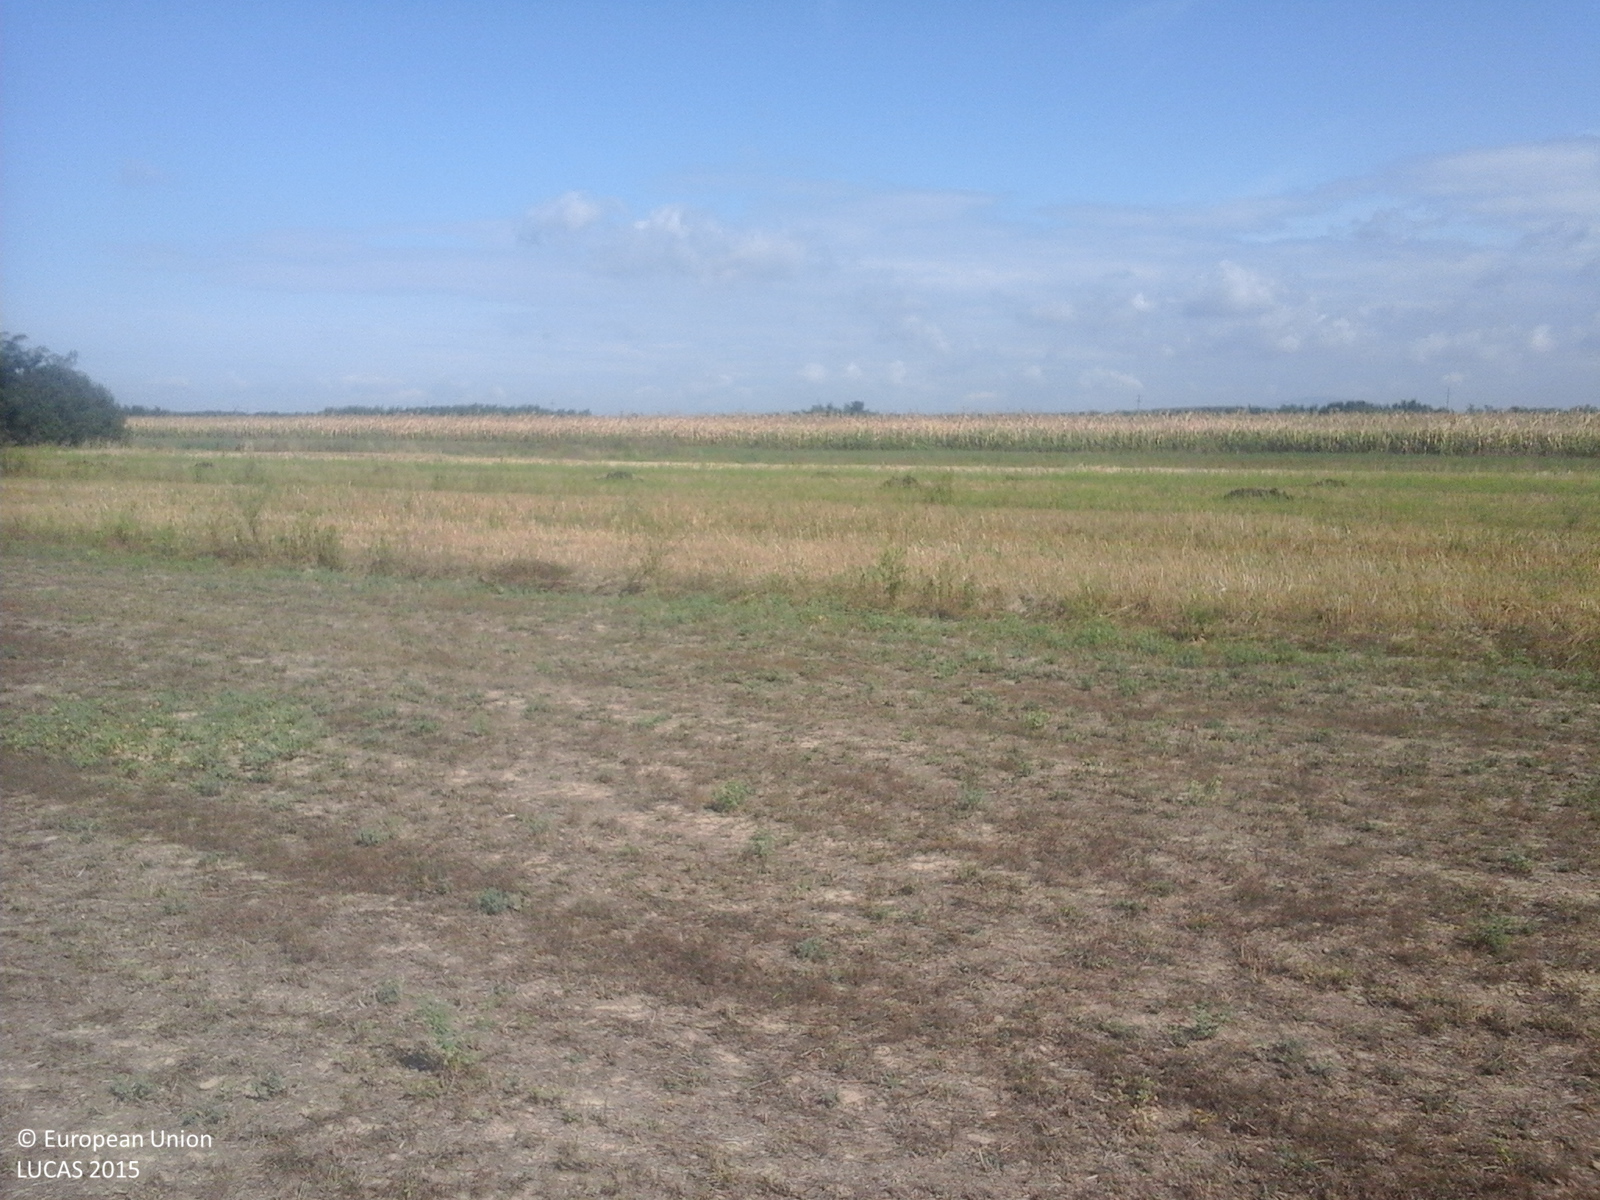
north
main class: Cropland
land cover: Lucerne
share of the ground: > 75 %
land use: Agriculture (excluding fallow land and kitchen gardens)
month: September
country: RO
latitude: 47.9112
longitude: 22.9511
